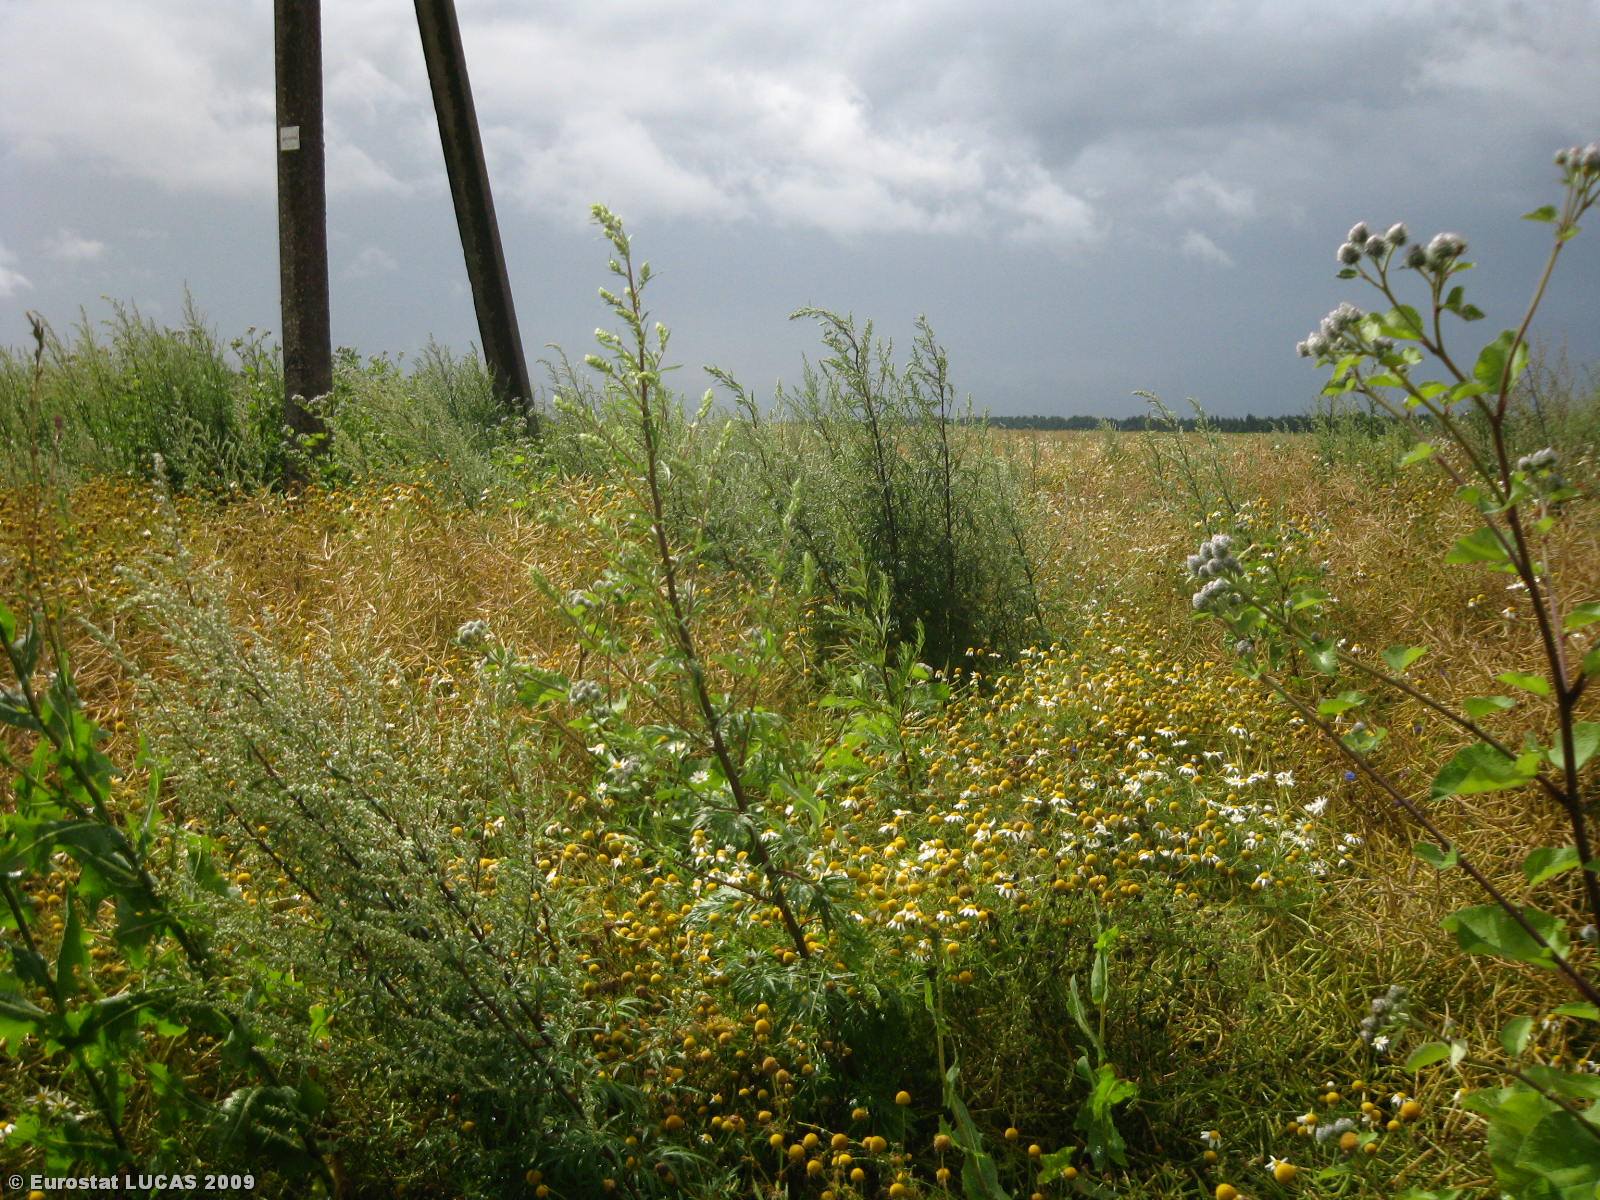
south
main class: Cropland
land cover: Rape and turnip rape
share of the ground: > 75 %
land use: Agriculture (excluding fallow land and kitchen gardens)
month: July
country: LT
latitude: 55.5088
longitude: 23.8135
